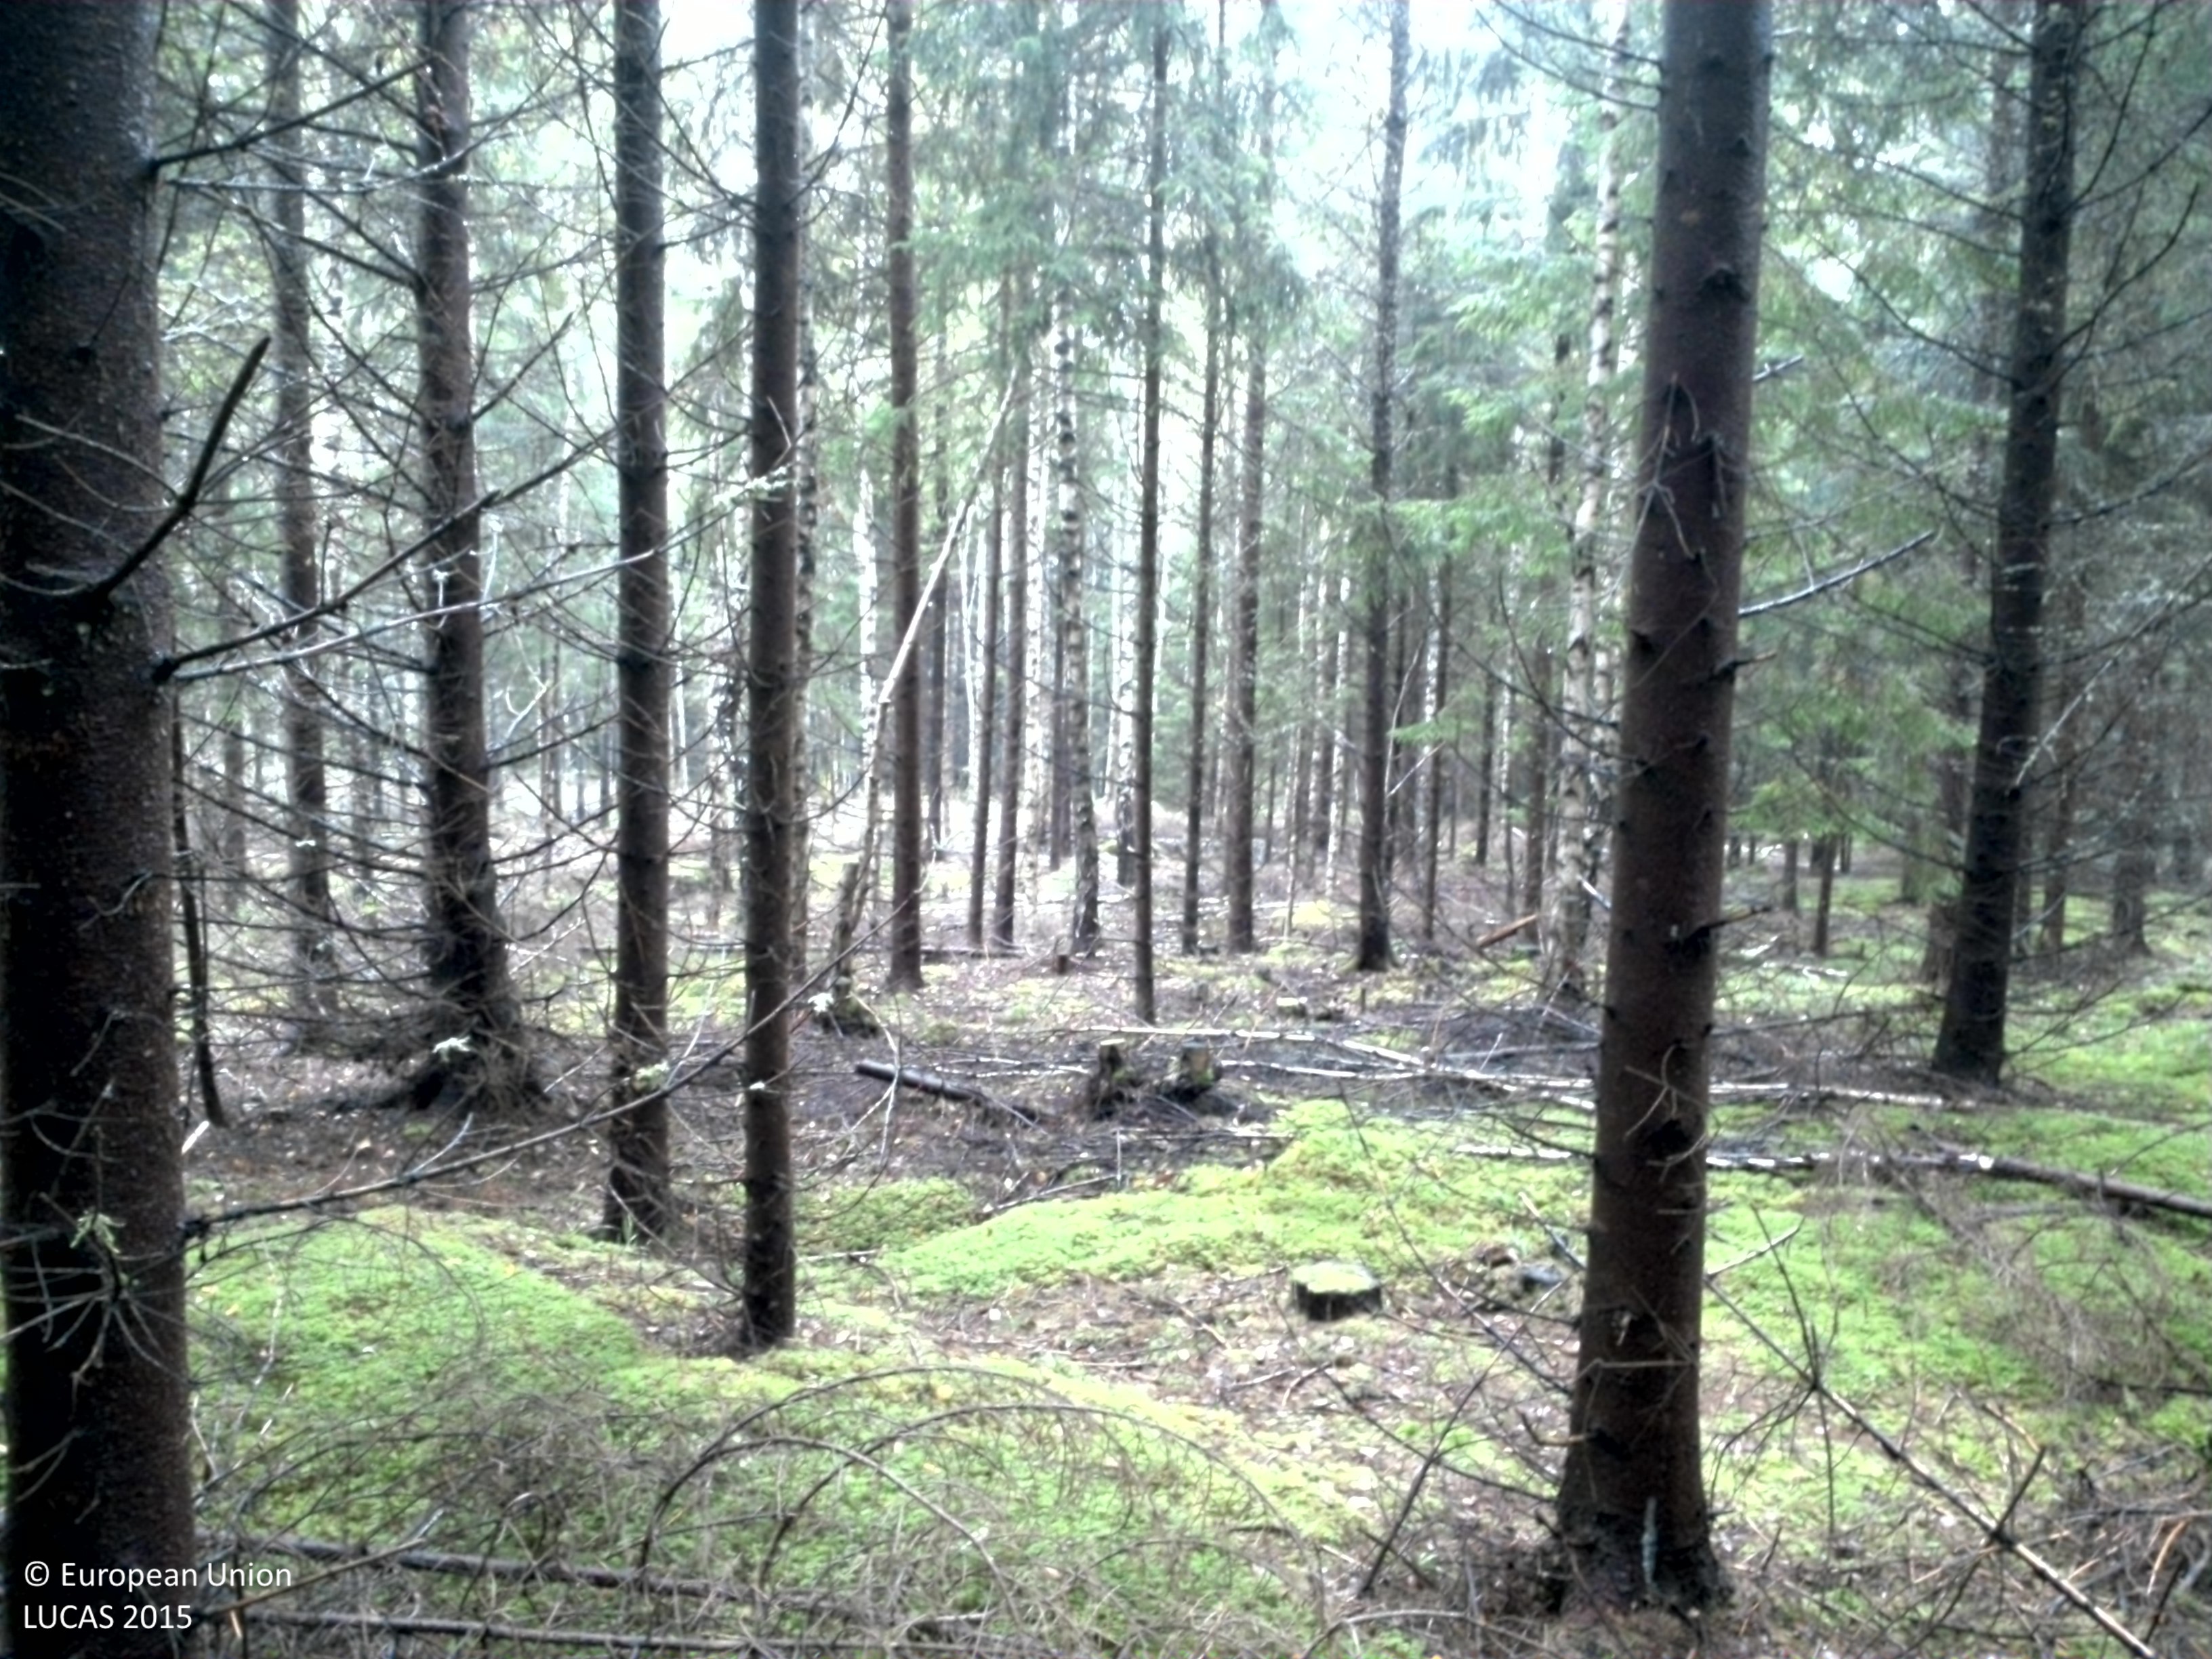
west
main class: Woodland
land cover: Spruce dominated coniferous woodland
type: boreal forest
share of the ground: 50 - 75 %
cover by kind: coniferous forest trees 60 %, lichens and mosses 35 %, herbaceous plants 5 %
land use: Forestry
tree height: > 5 m
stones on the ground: > 50 %
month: September
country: SE
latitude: 58.9334
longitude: 14.0407
